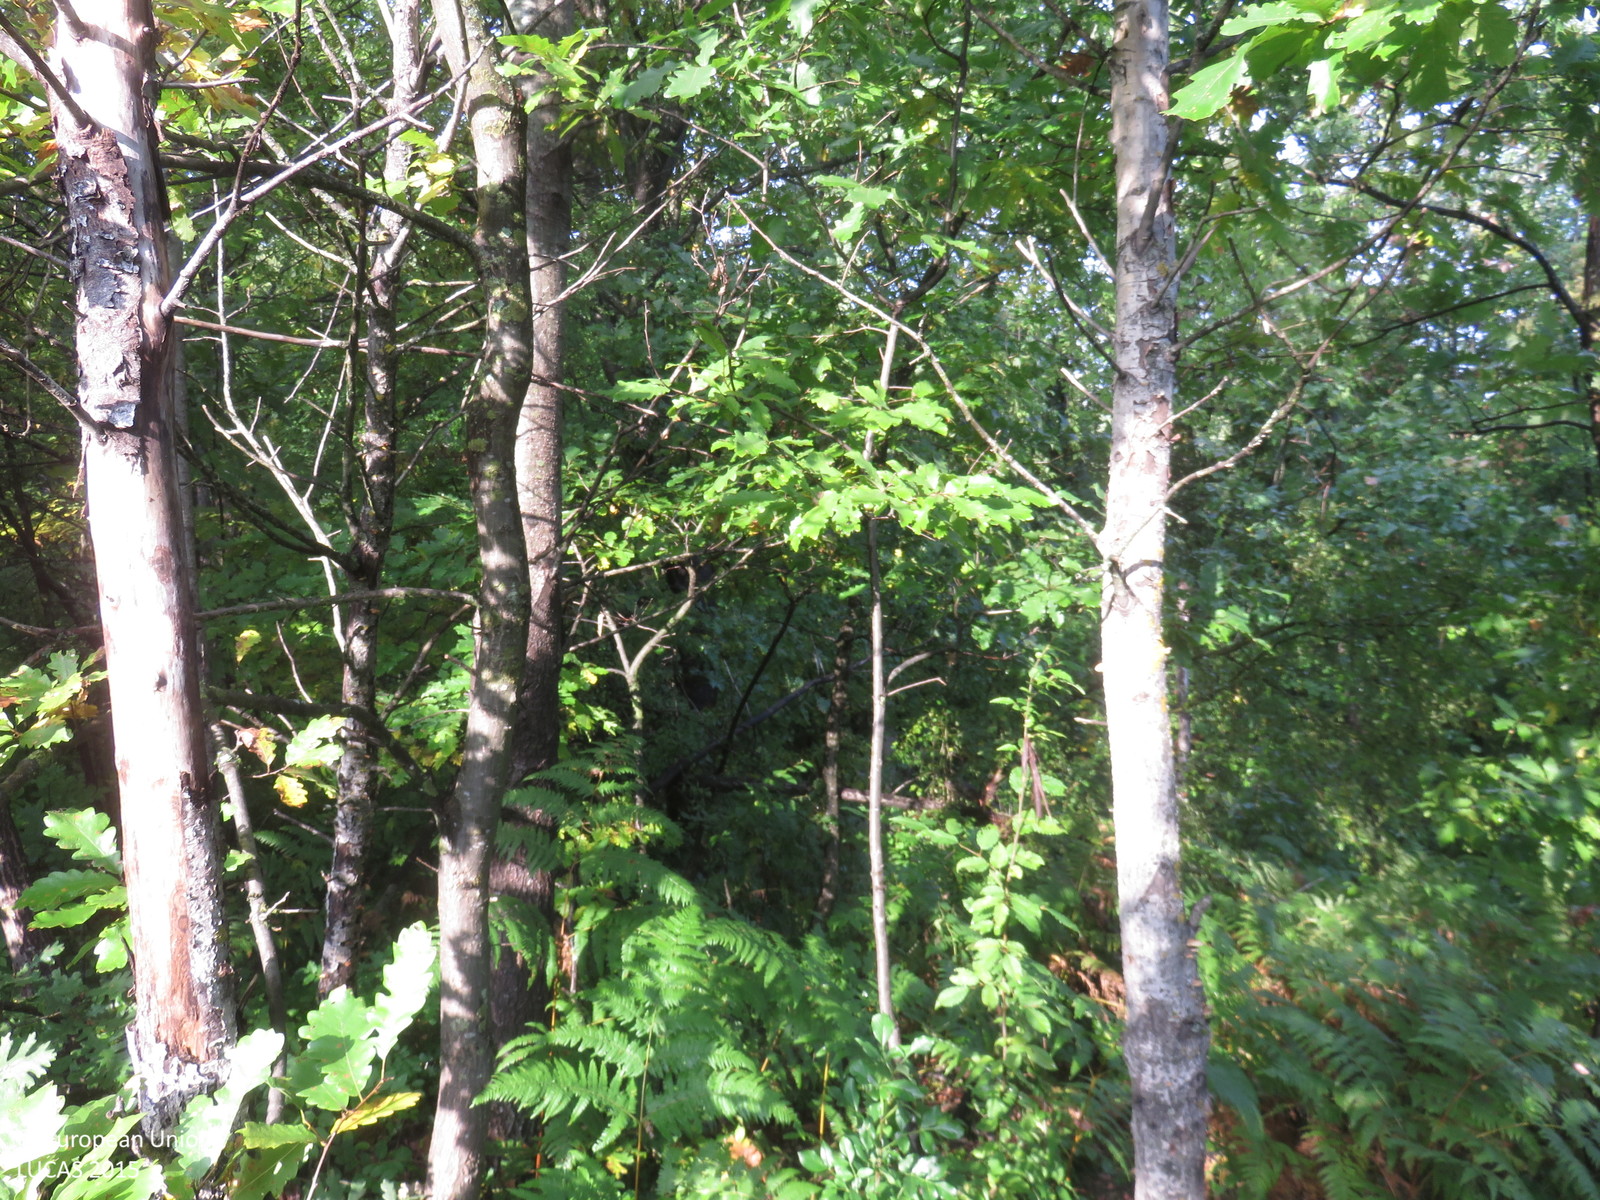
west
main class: Woodland
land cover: Broadleaved woodland
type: mesophytic deciduous forest
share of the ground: > 75 %
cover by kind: broadleaved forest trees 90 %, shrubs 5 %, herbaceous plants 5 %
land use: Forestry
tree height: > 5 m
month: October
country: BG
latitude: 42.8766
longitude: 25.1874
